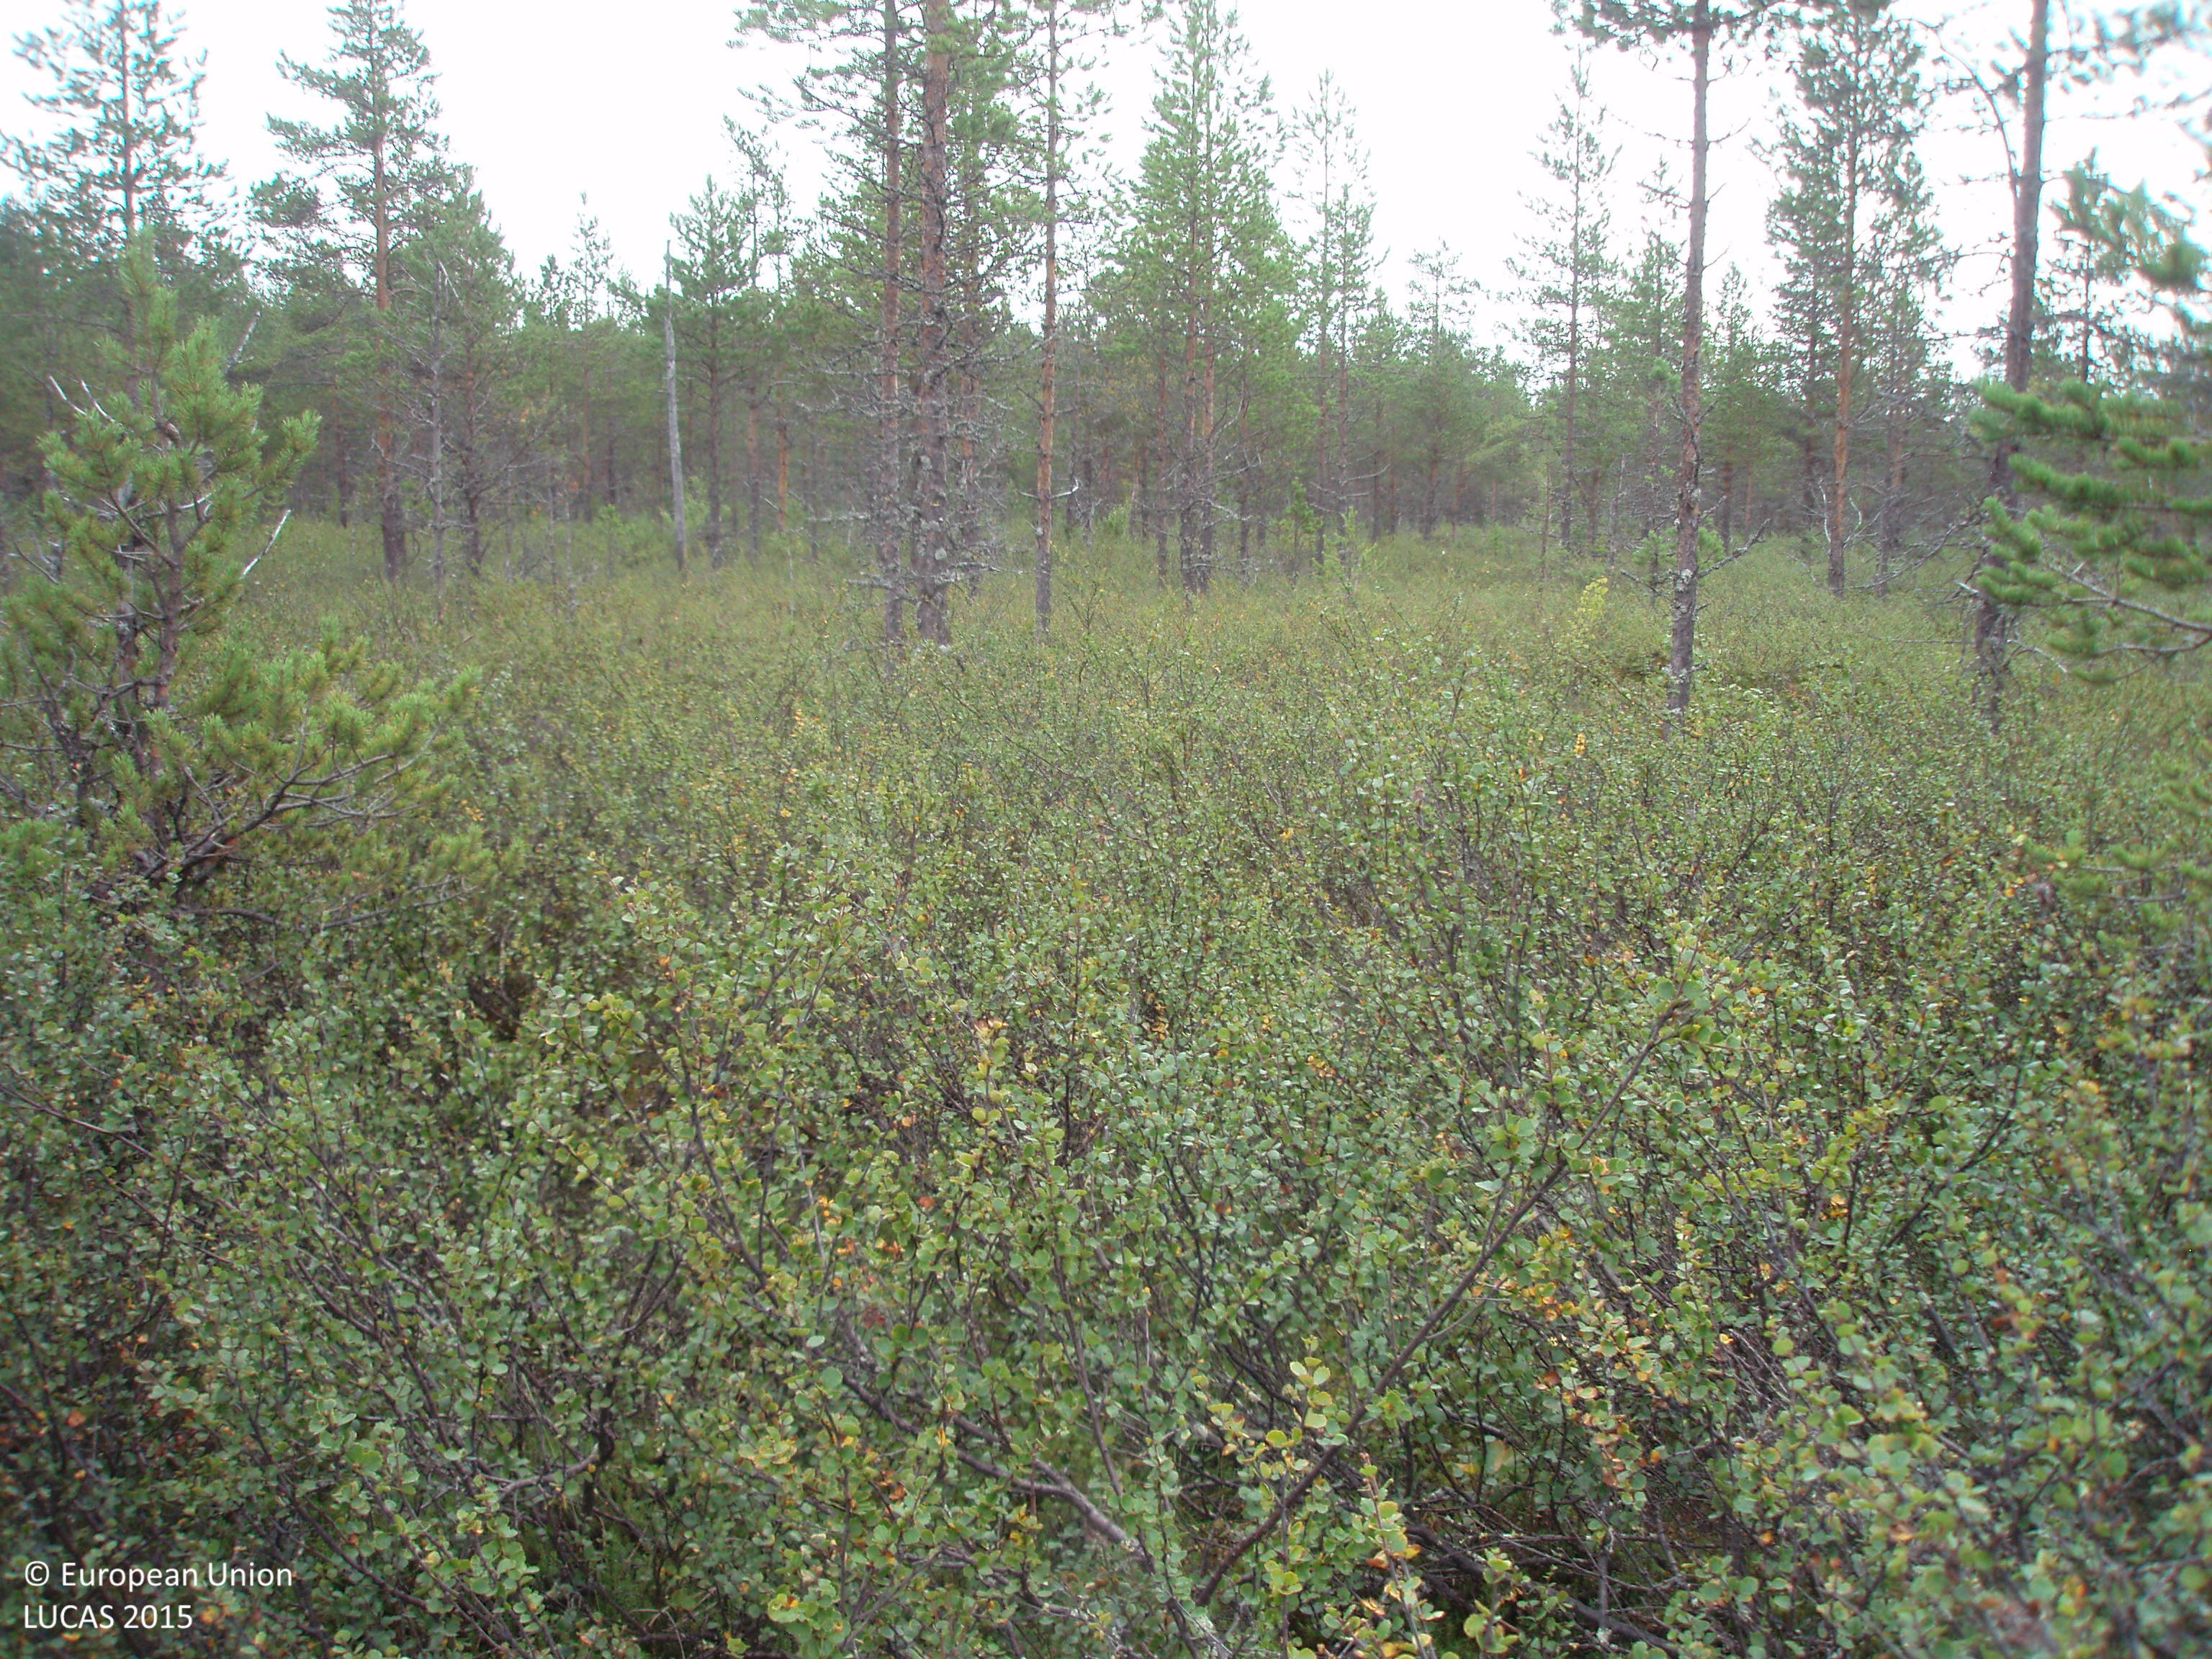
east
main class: Woodland
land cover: Pine dominated coniferous woodland
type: boreal forest
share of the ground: 10 - 25 %
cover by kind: shrubs 80 %, coniferous forest trees 20 %
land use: Forestry
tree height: > 5 m
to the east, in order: Pine dominated coniferous woodland; Ditches and canals; Pine dominated coniferous woodland; Ditches and canals; Pine dominated coniferous woodland; Ditches and canals; Pine dominated coniferous woodland; Pine dominated mixed woodland
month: August
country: FI
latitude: 65.4712
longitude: 27.0632
